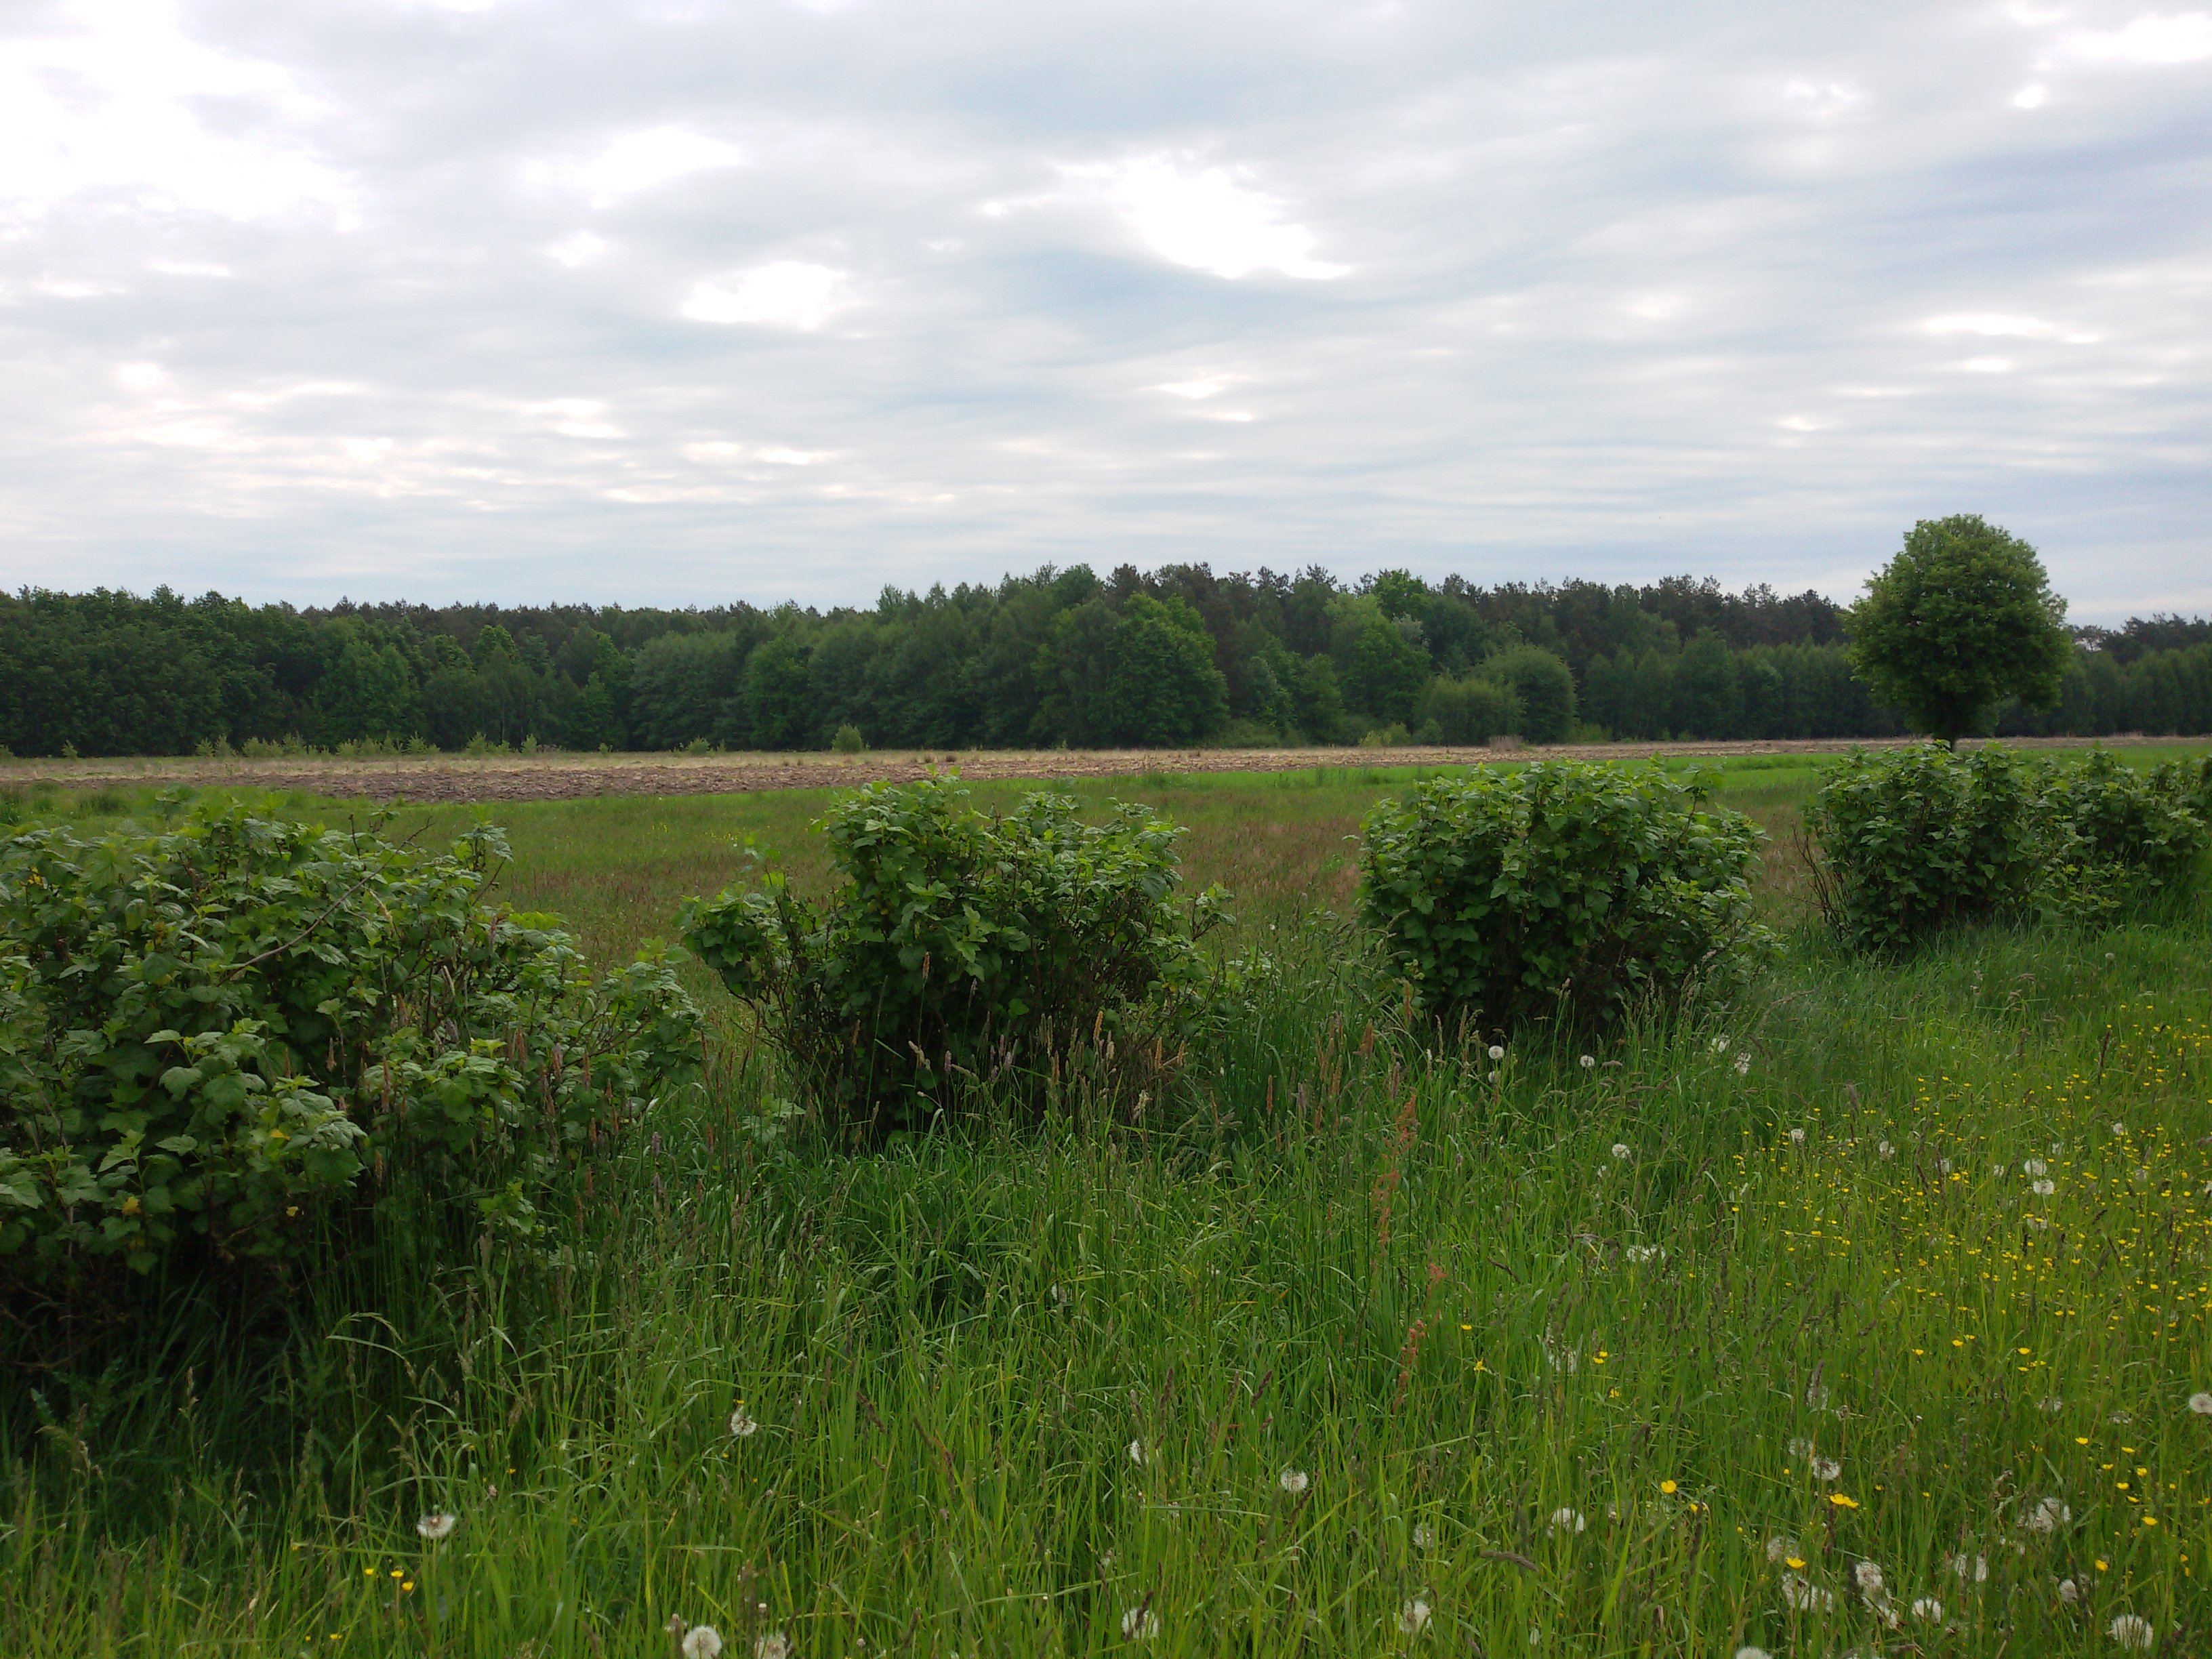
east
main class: Grassland
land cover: Grassland without tree/shrub cover
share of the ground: > 75 %
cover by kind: herbaceous plants 100 %
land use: Agriculture (excluding fallow land and kitchen gardens)
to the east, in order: Grassland without tree/shrub cover; Other fruit trees and berries; Grassland without tree/shrub cover; Oats; Other bare soil; Grassland without tree/shrub cover; Pine dominated mixed woodland
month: May
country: PL
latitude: 51.7260
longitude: 21.6791
